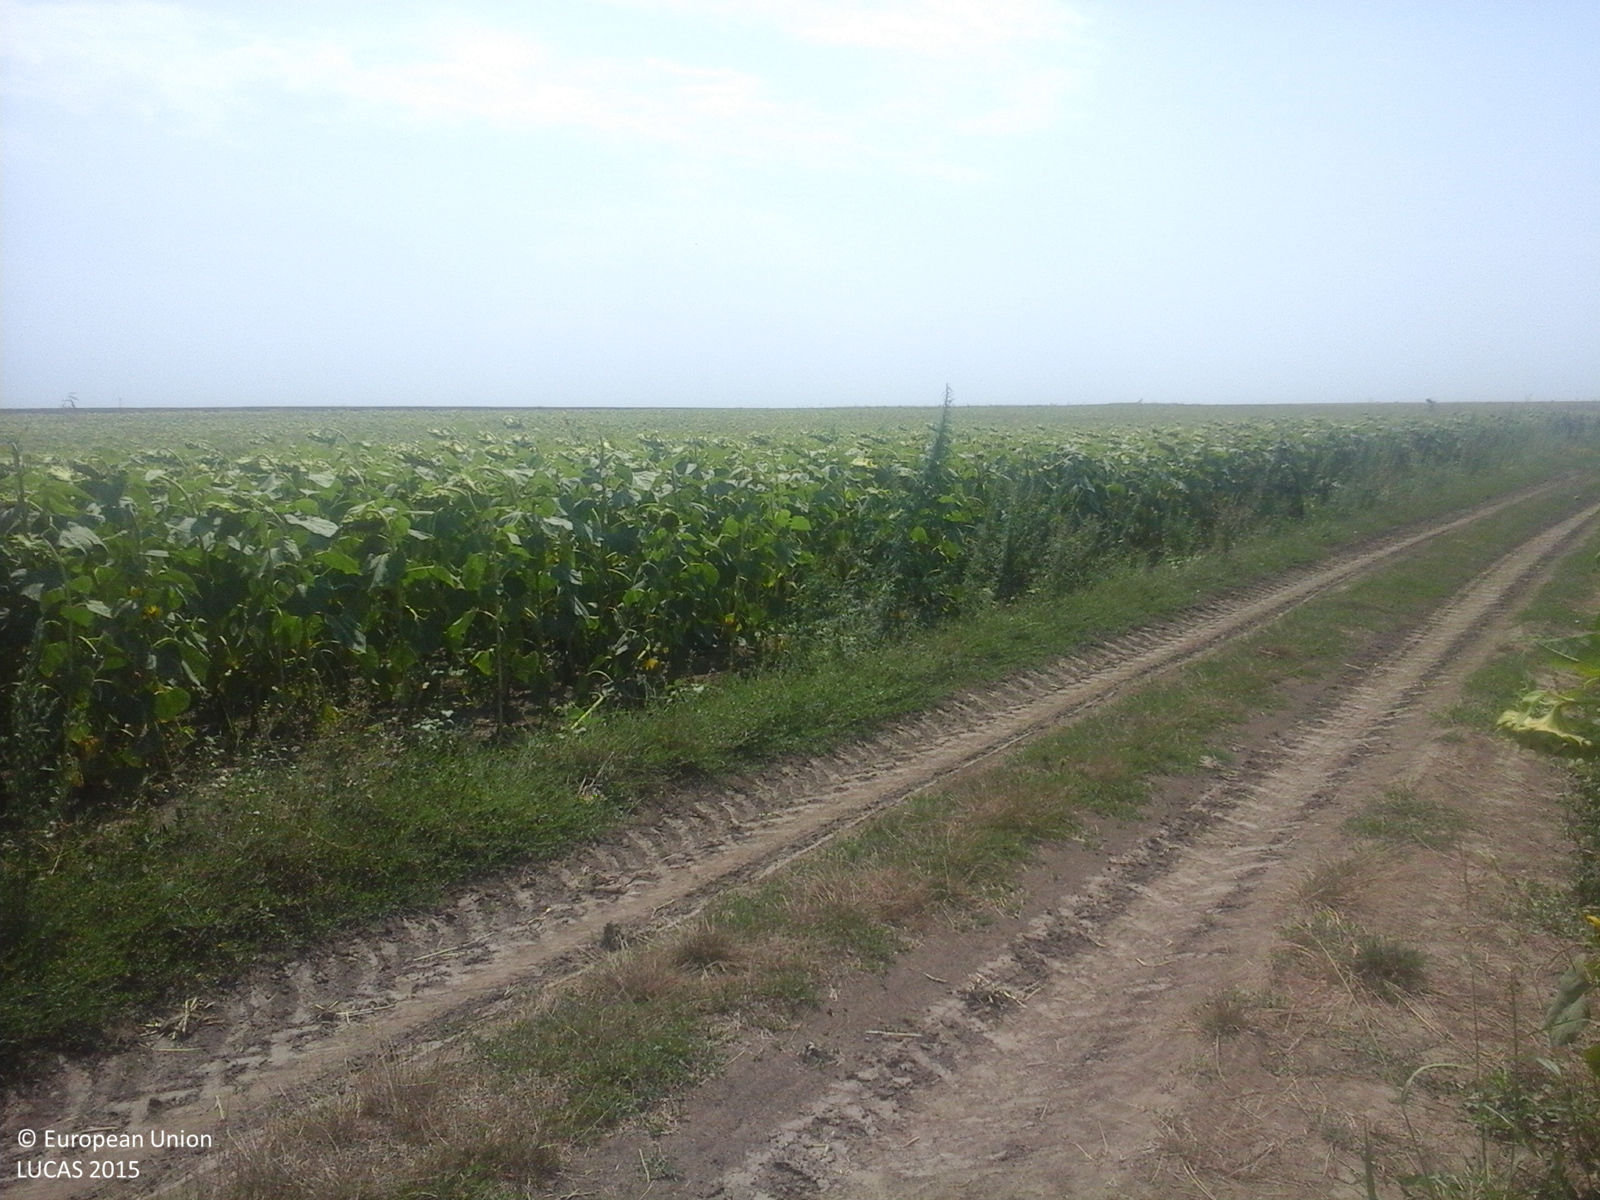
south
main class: Cropland
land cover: Sunflower
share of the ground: > 75 %
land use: Agriculture (excluding fallow land and kitchen gardens)
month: August
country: RO
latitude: 43.8359
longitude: 28.1759
